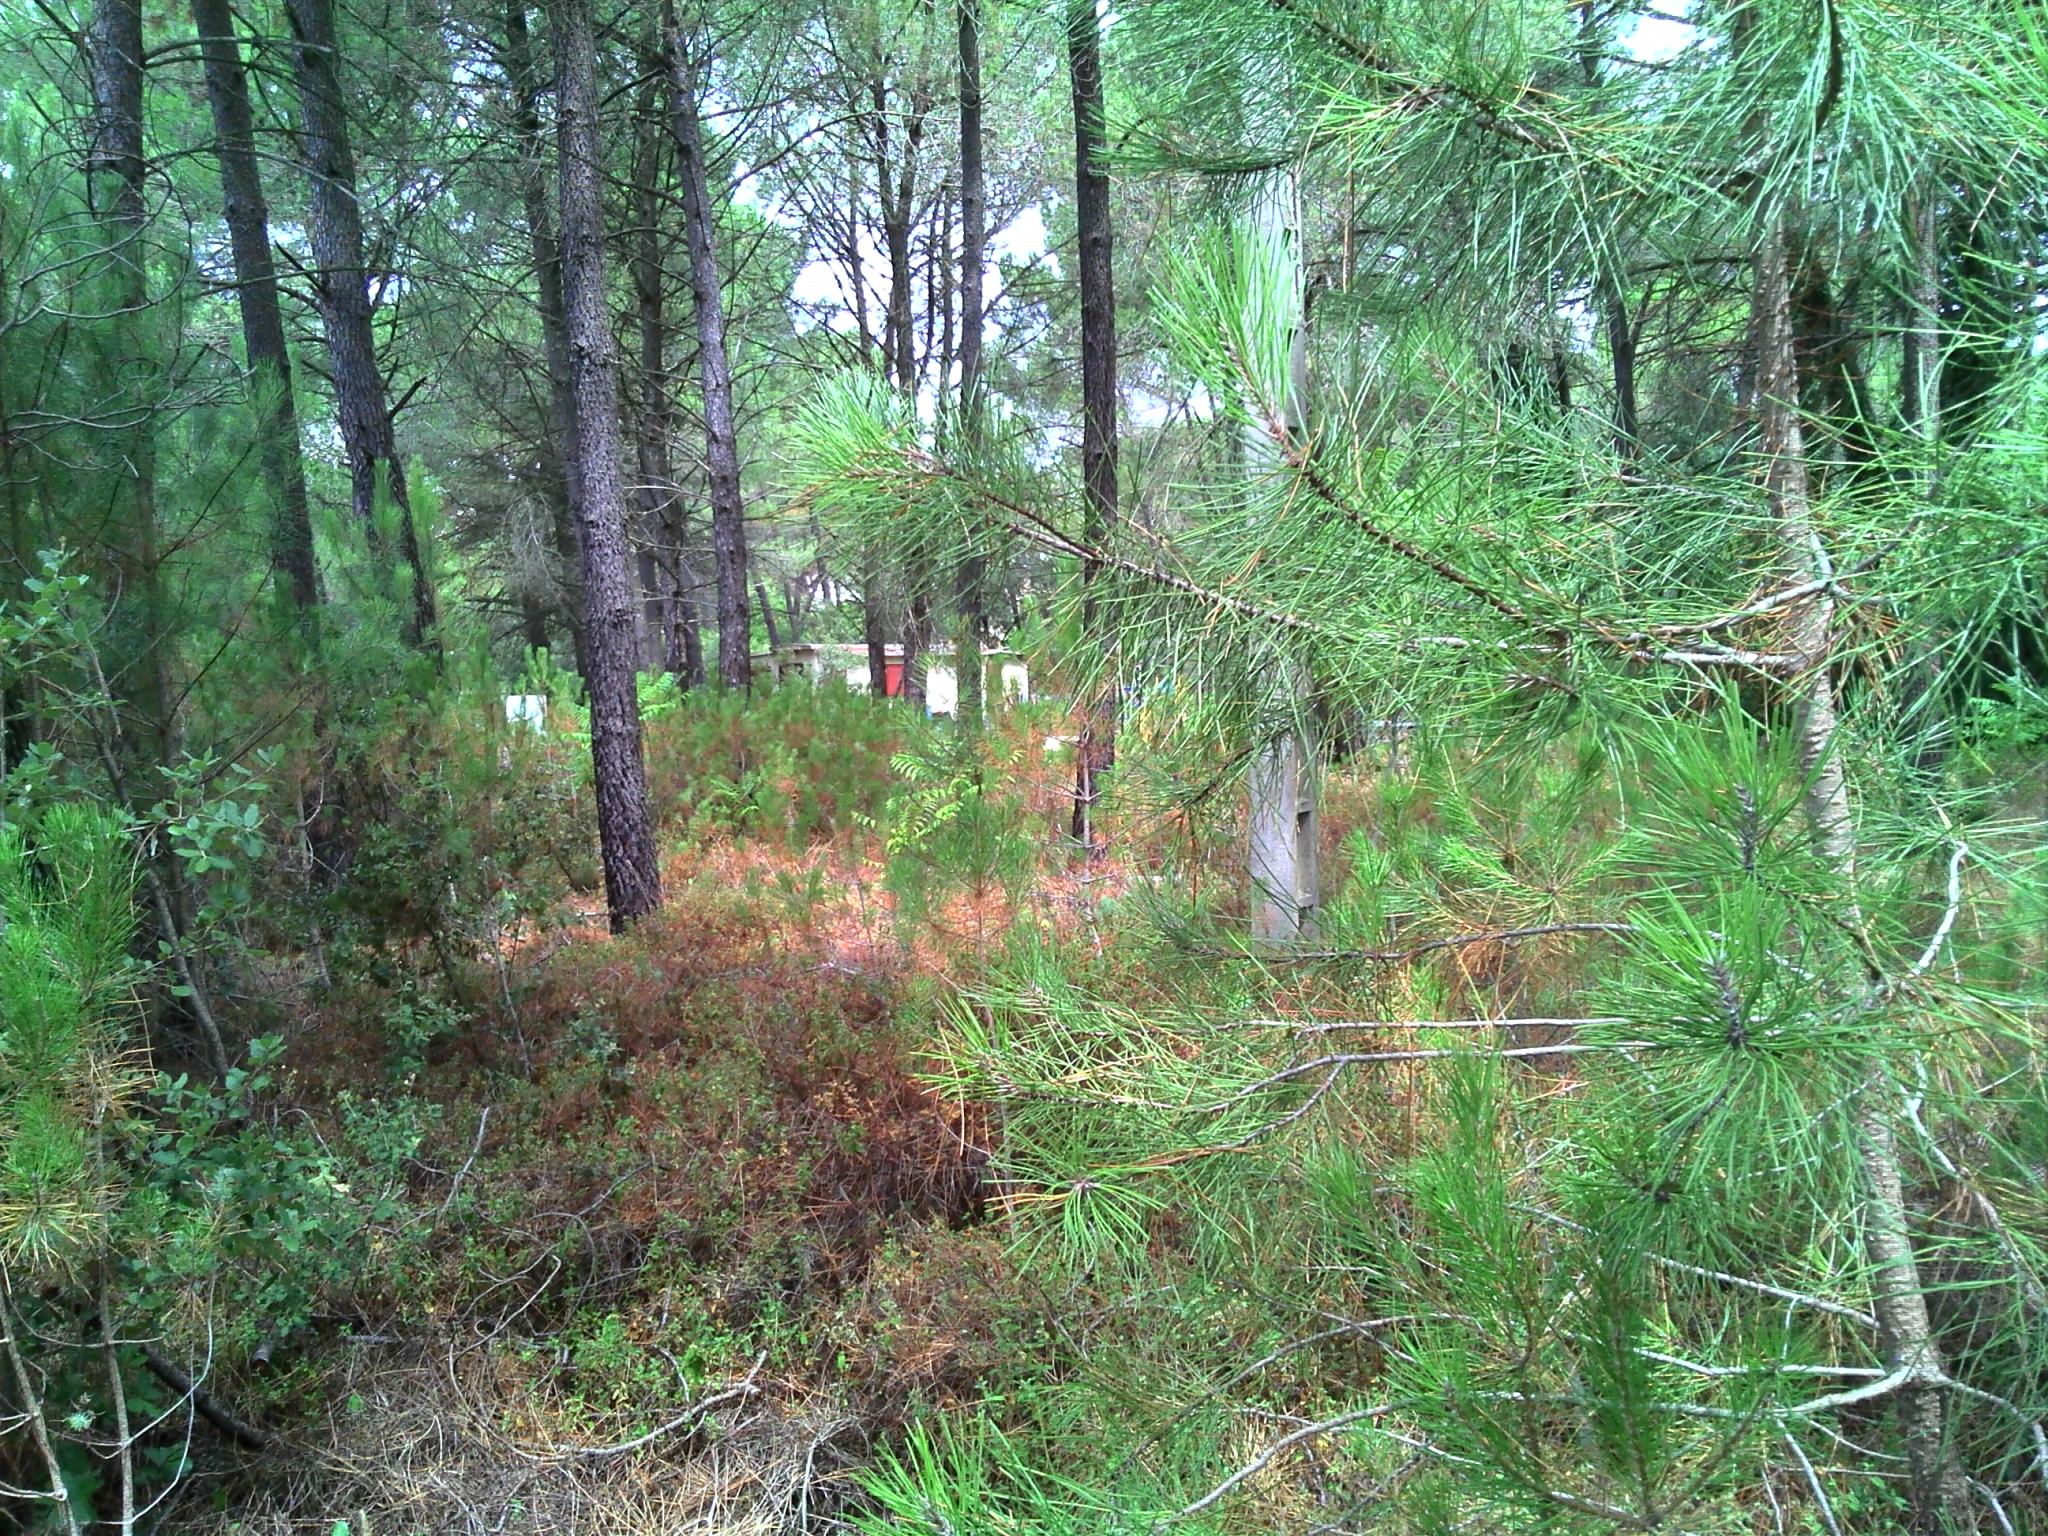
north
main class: Woodland
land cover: Pine dominated coniferous woodland
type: coniferous forest of the mediterranean region
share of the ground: > 75 %
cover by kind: coniferous forest trees 60 %, herbaceous plants 20 %, shrubs 10 %, consolidated bare surface 10 %
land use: Semi-natural and natural areas not in use
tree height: > 5 m
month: August
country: FR
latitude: 44.1387
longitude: 4.6204
